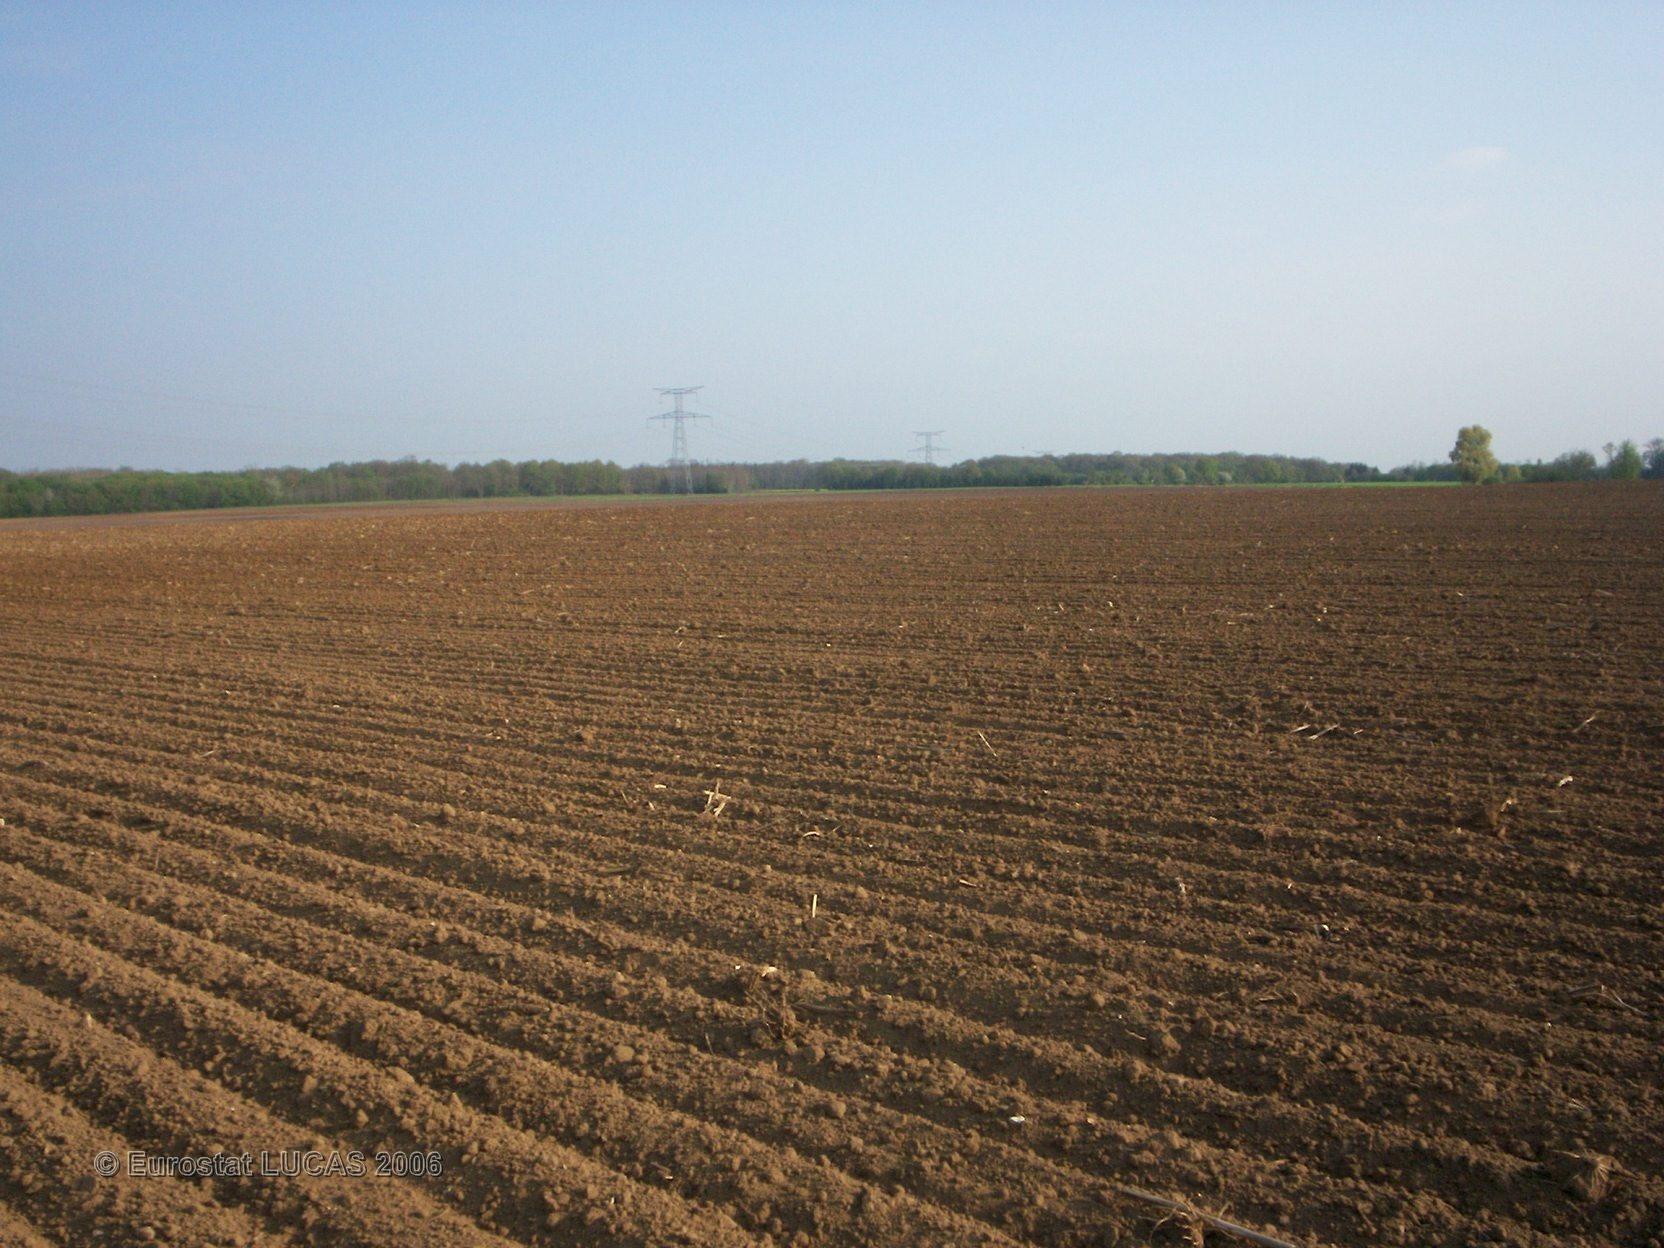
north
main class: Cropland
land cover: Maize
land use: Agriculture (excluding fallow land and kitchen gardens)
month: May
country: FR
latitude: 47.2085
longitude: 3.0375
